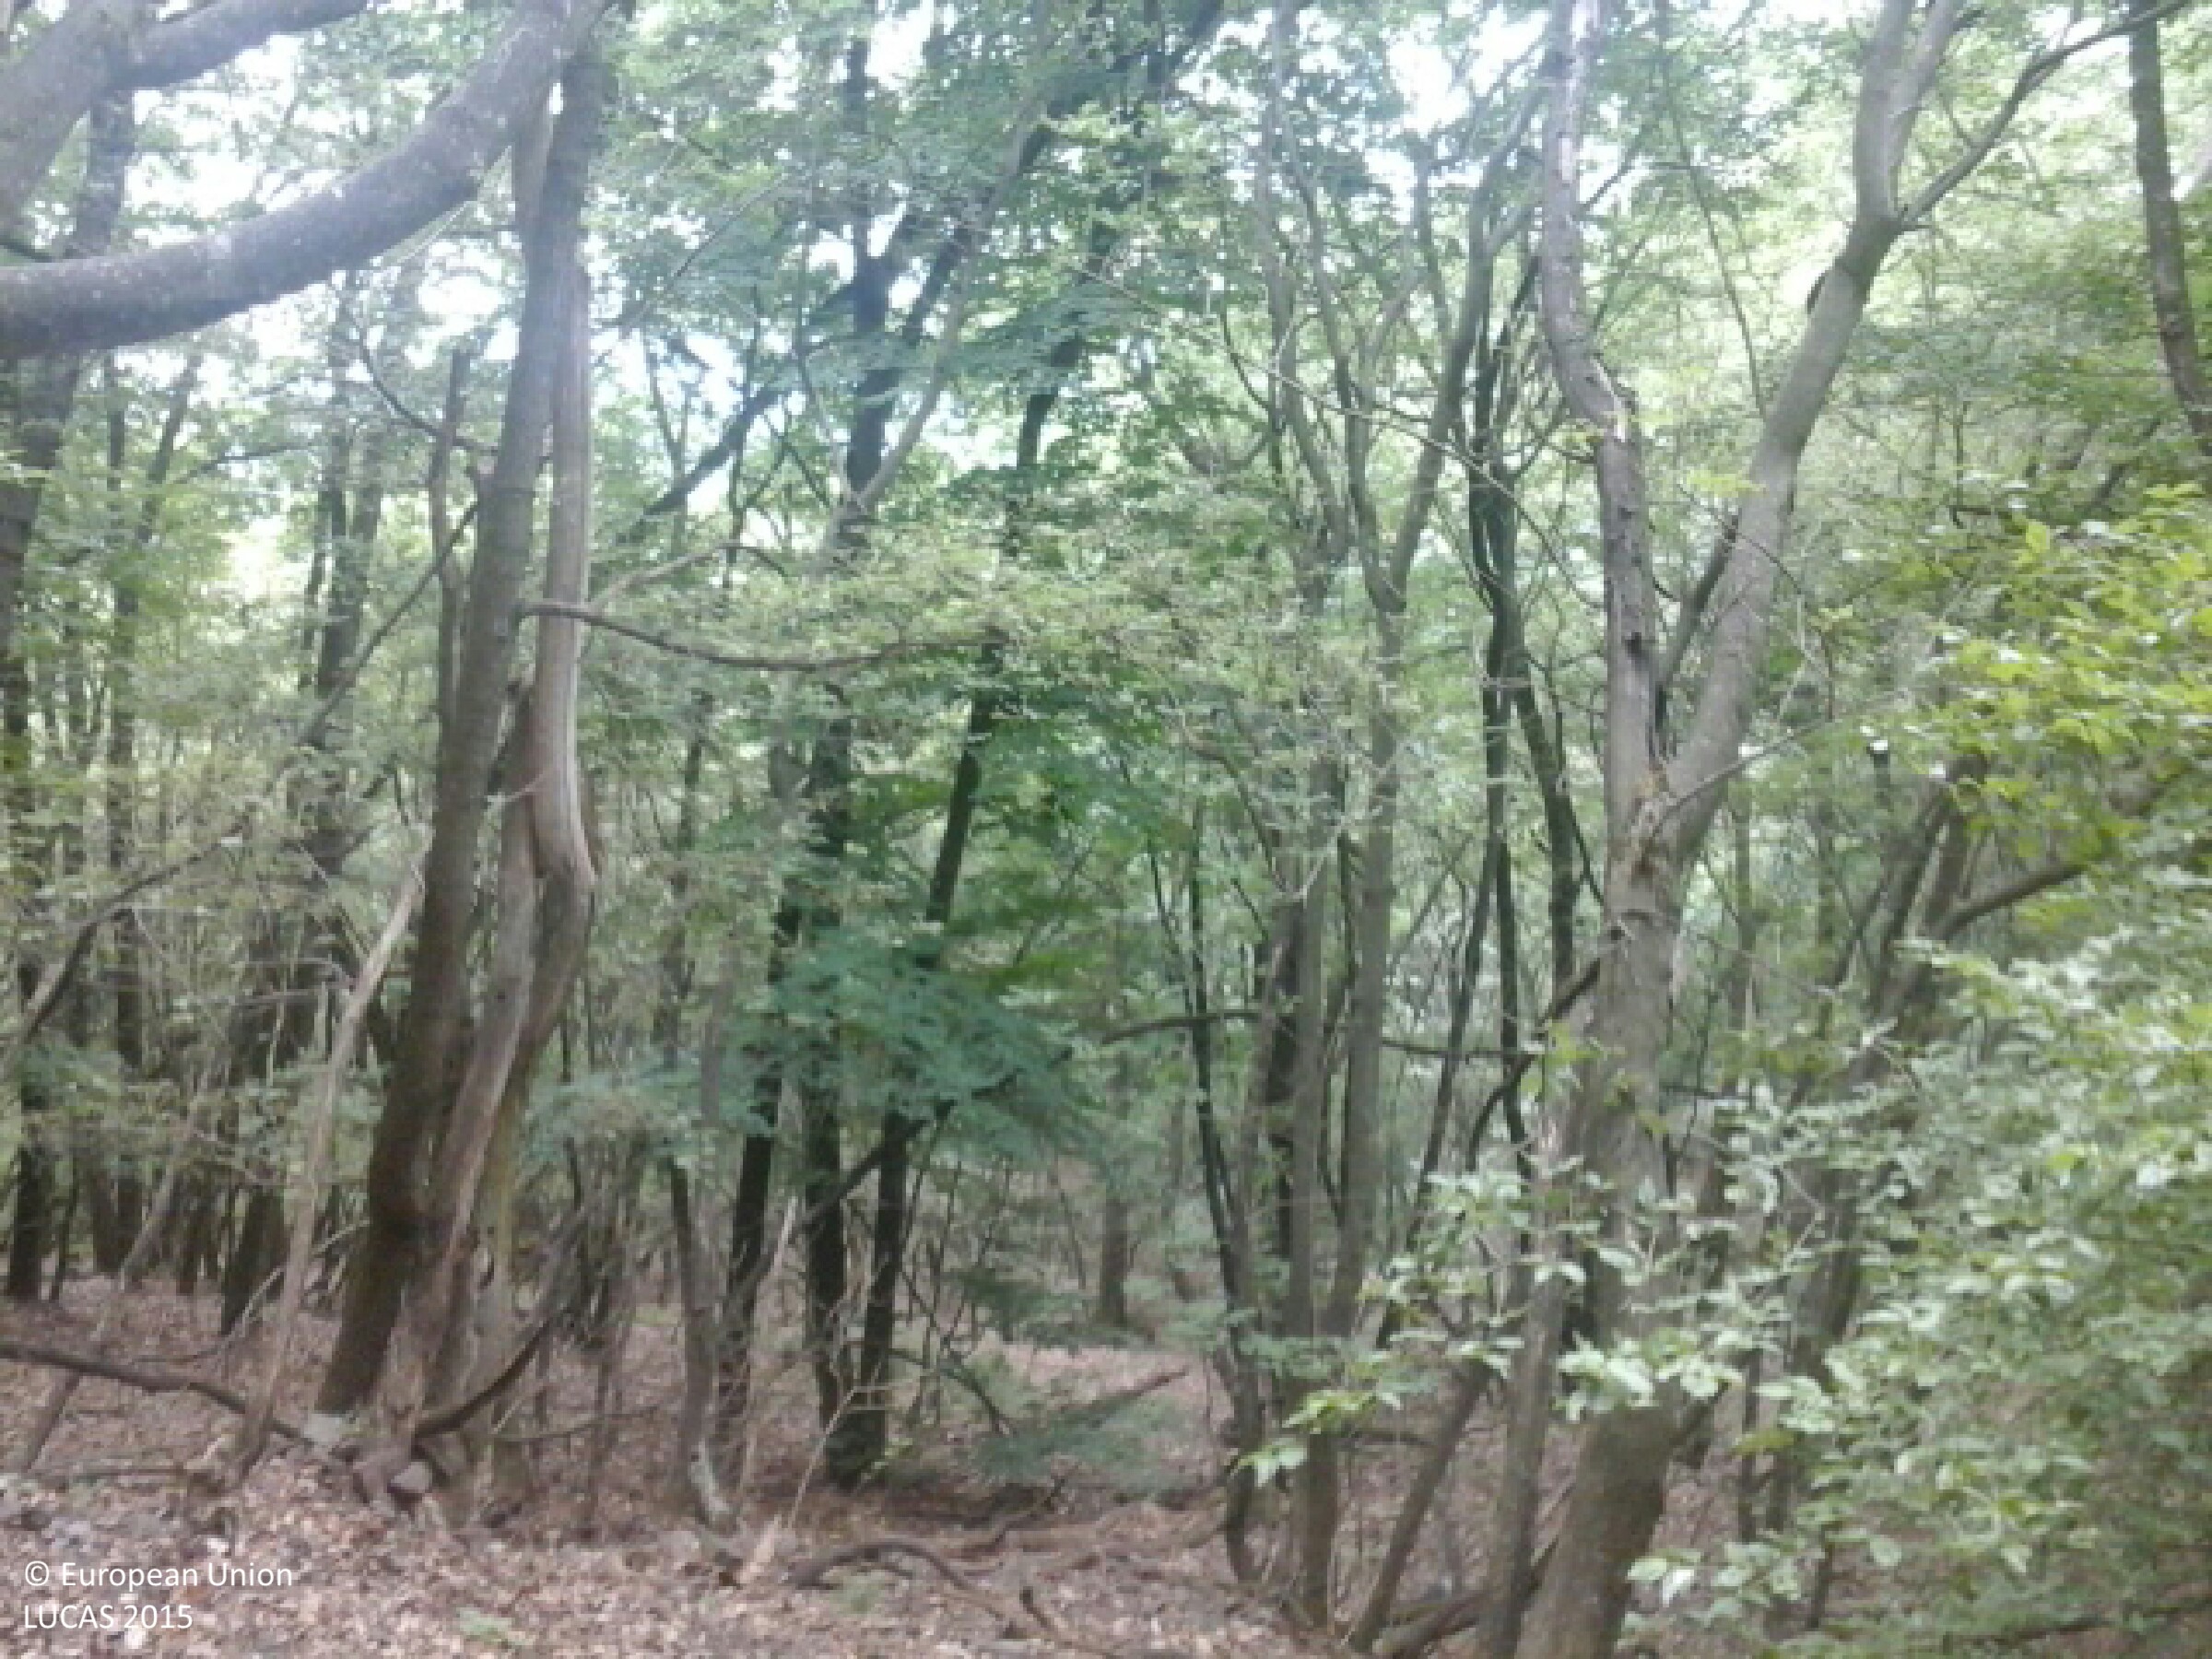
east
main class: Woodland
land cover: Broadleaved woodland
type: mesophytic deciduous forest
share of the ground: > 75 %
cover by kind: broadleaved forest trees 95 %, unconsolidated bare surface 5 %
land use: Forestry
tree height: > 5 m
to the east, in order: Broadleaved woodland; Tracks; Shrubland with sparse tree cover; Electric lines; Shrubland with sparse tree cover; Broadleaved woodland
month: June
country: HU
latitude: 47.7043
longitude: 19.0676
